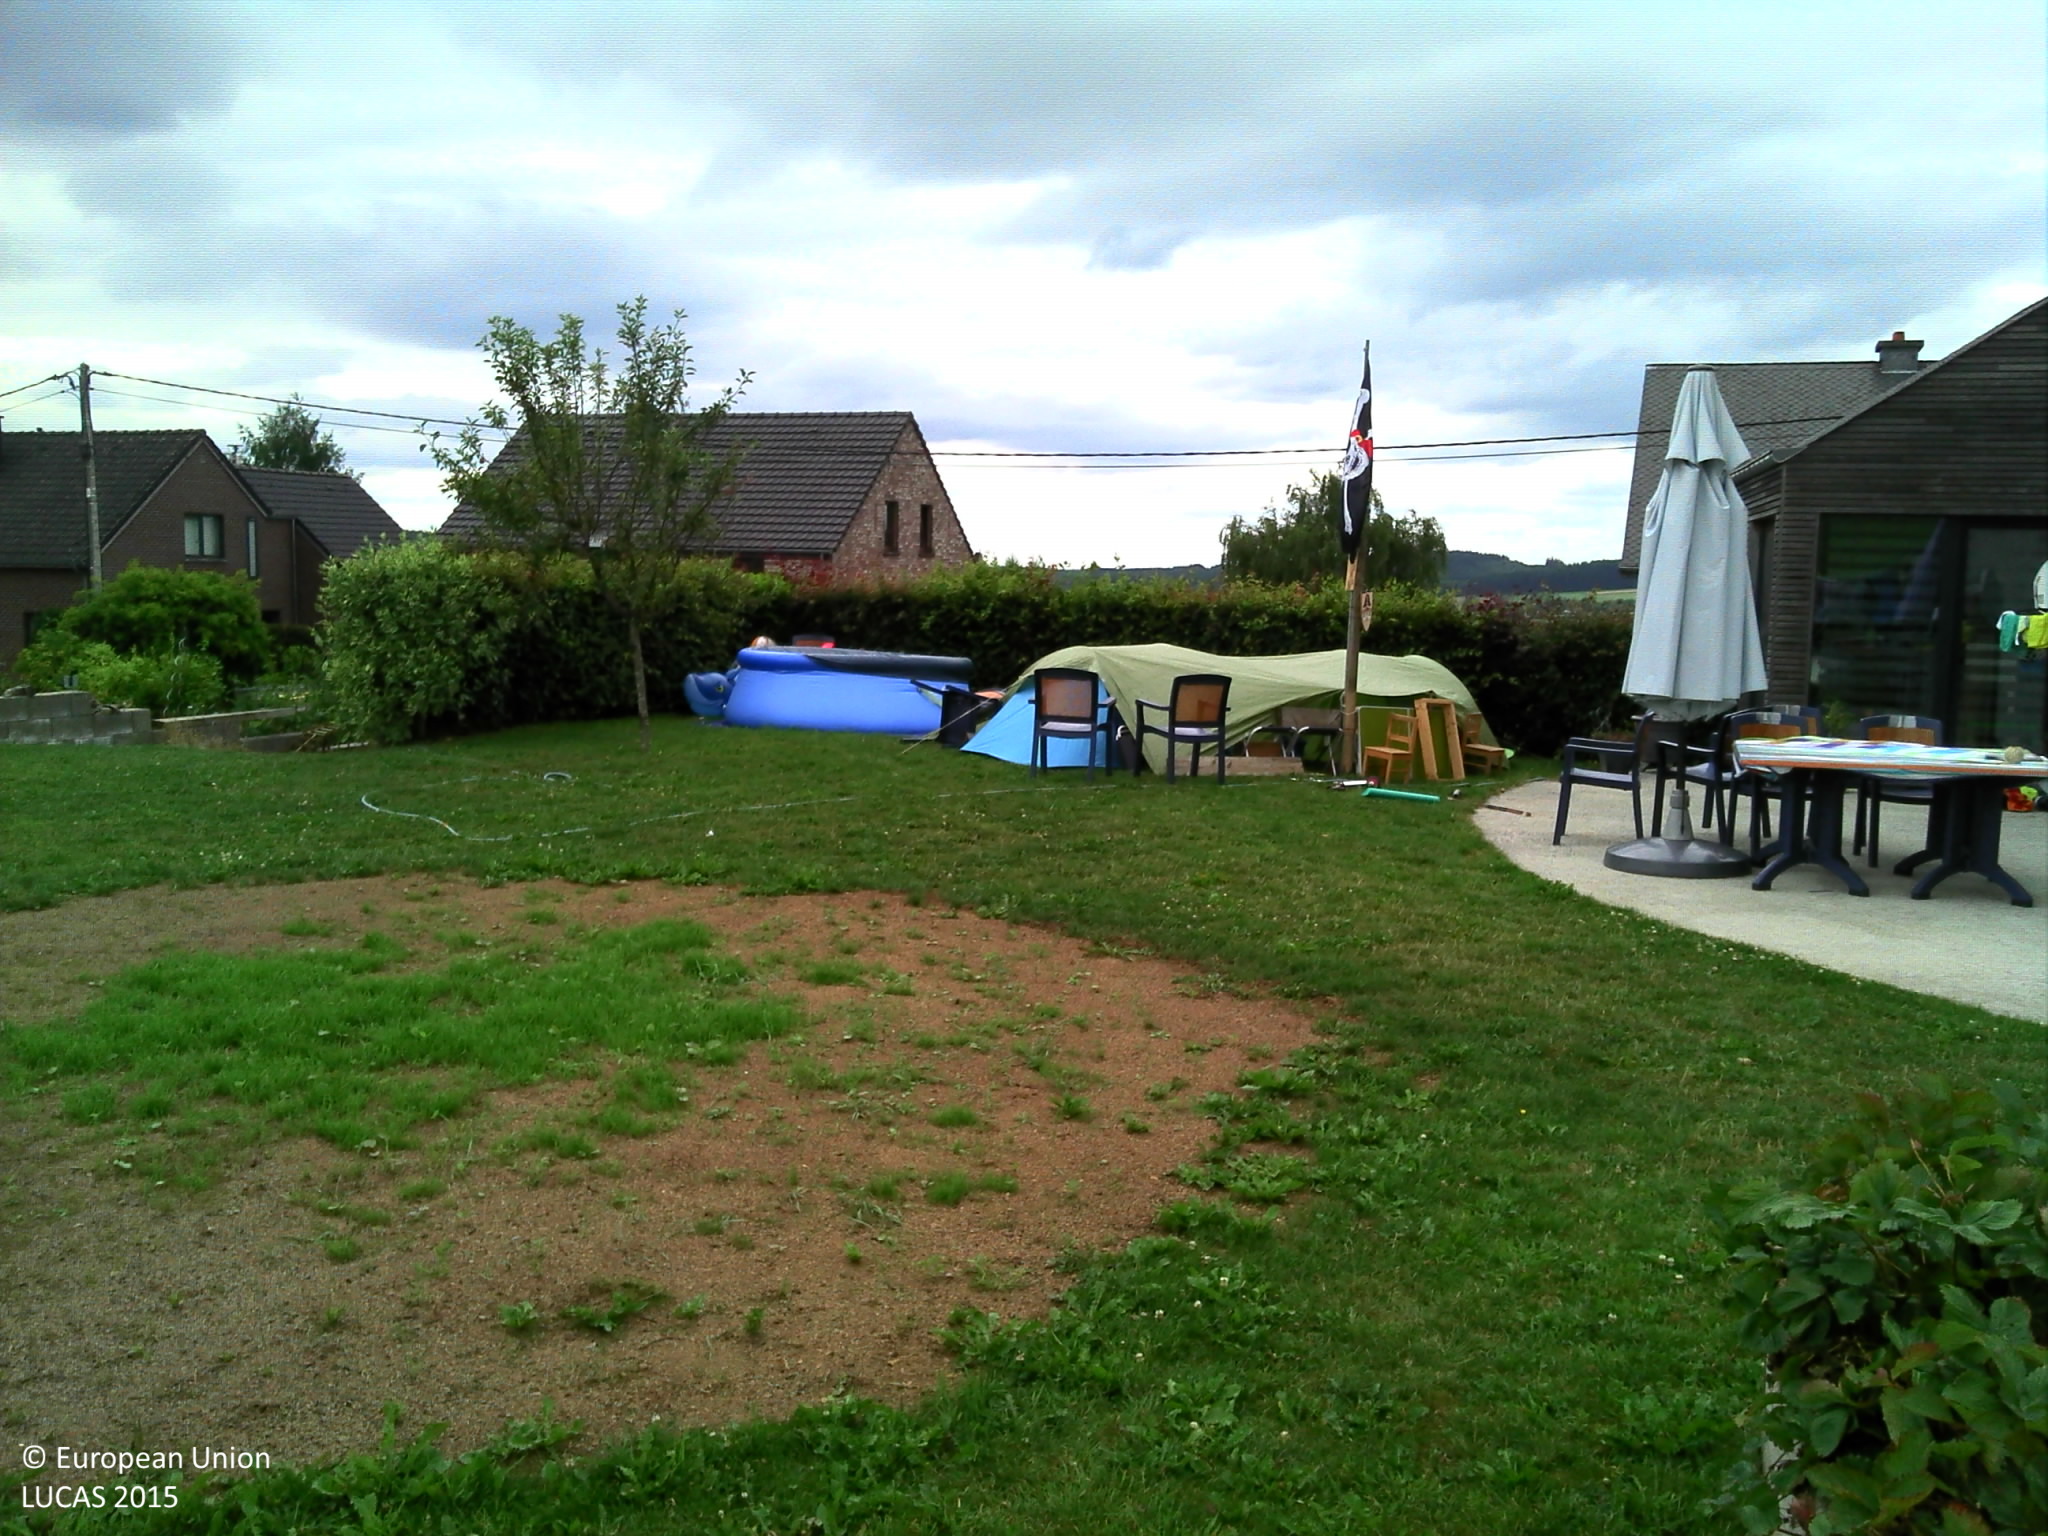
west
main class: Grassland
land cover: Grassland without tree/shrub cover
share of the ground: > 75 %
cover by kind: herbaceous plants 100 %
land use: Residential
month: July
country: BE
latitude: 49.7761
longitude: 5.6244
